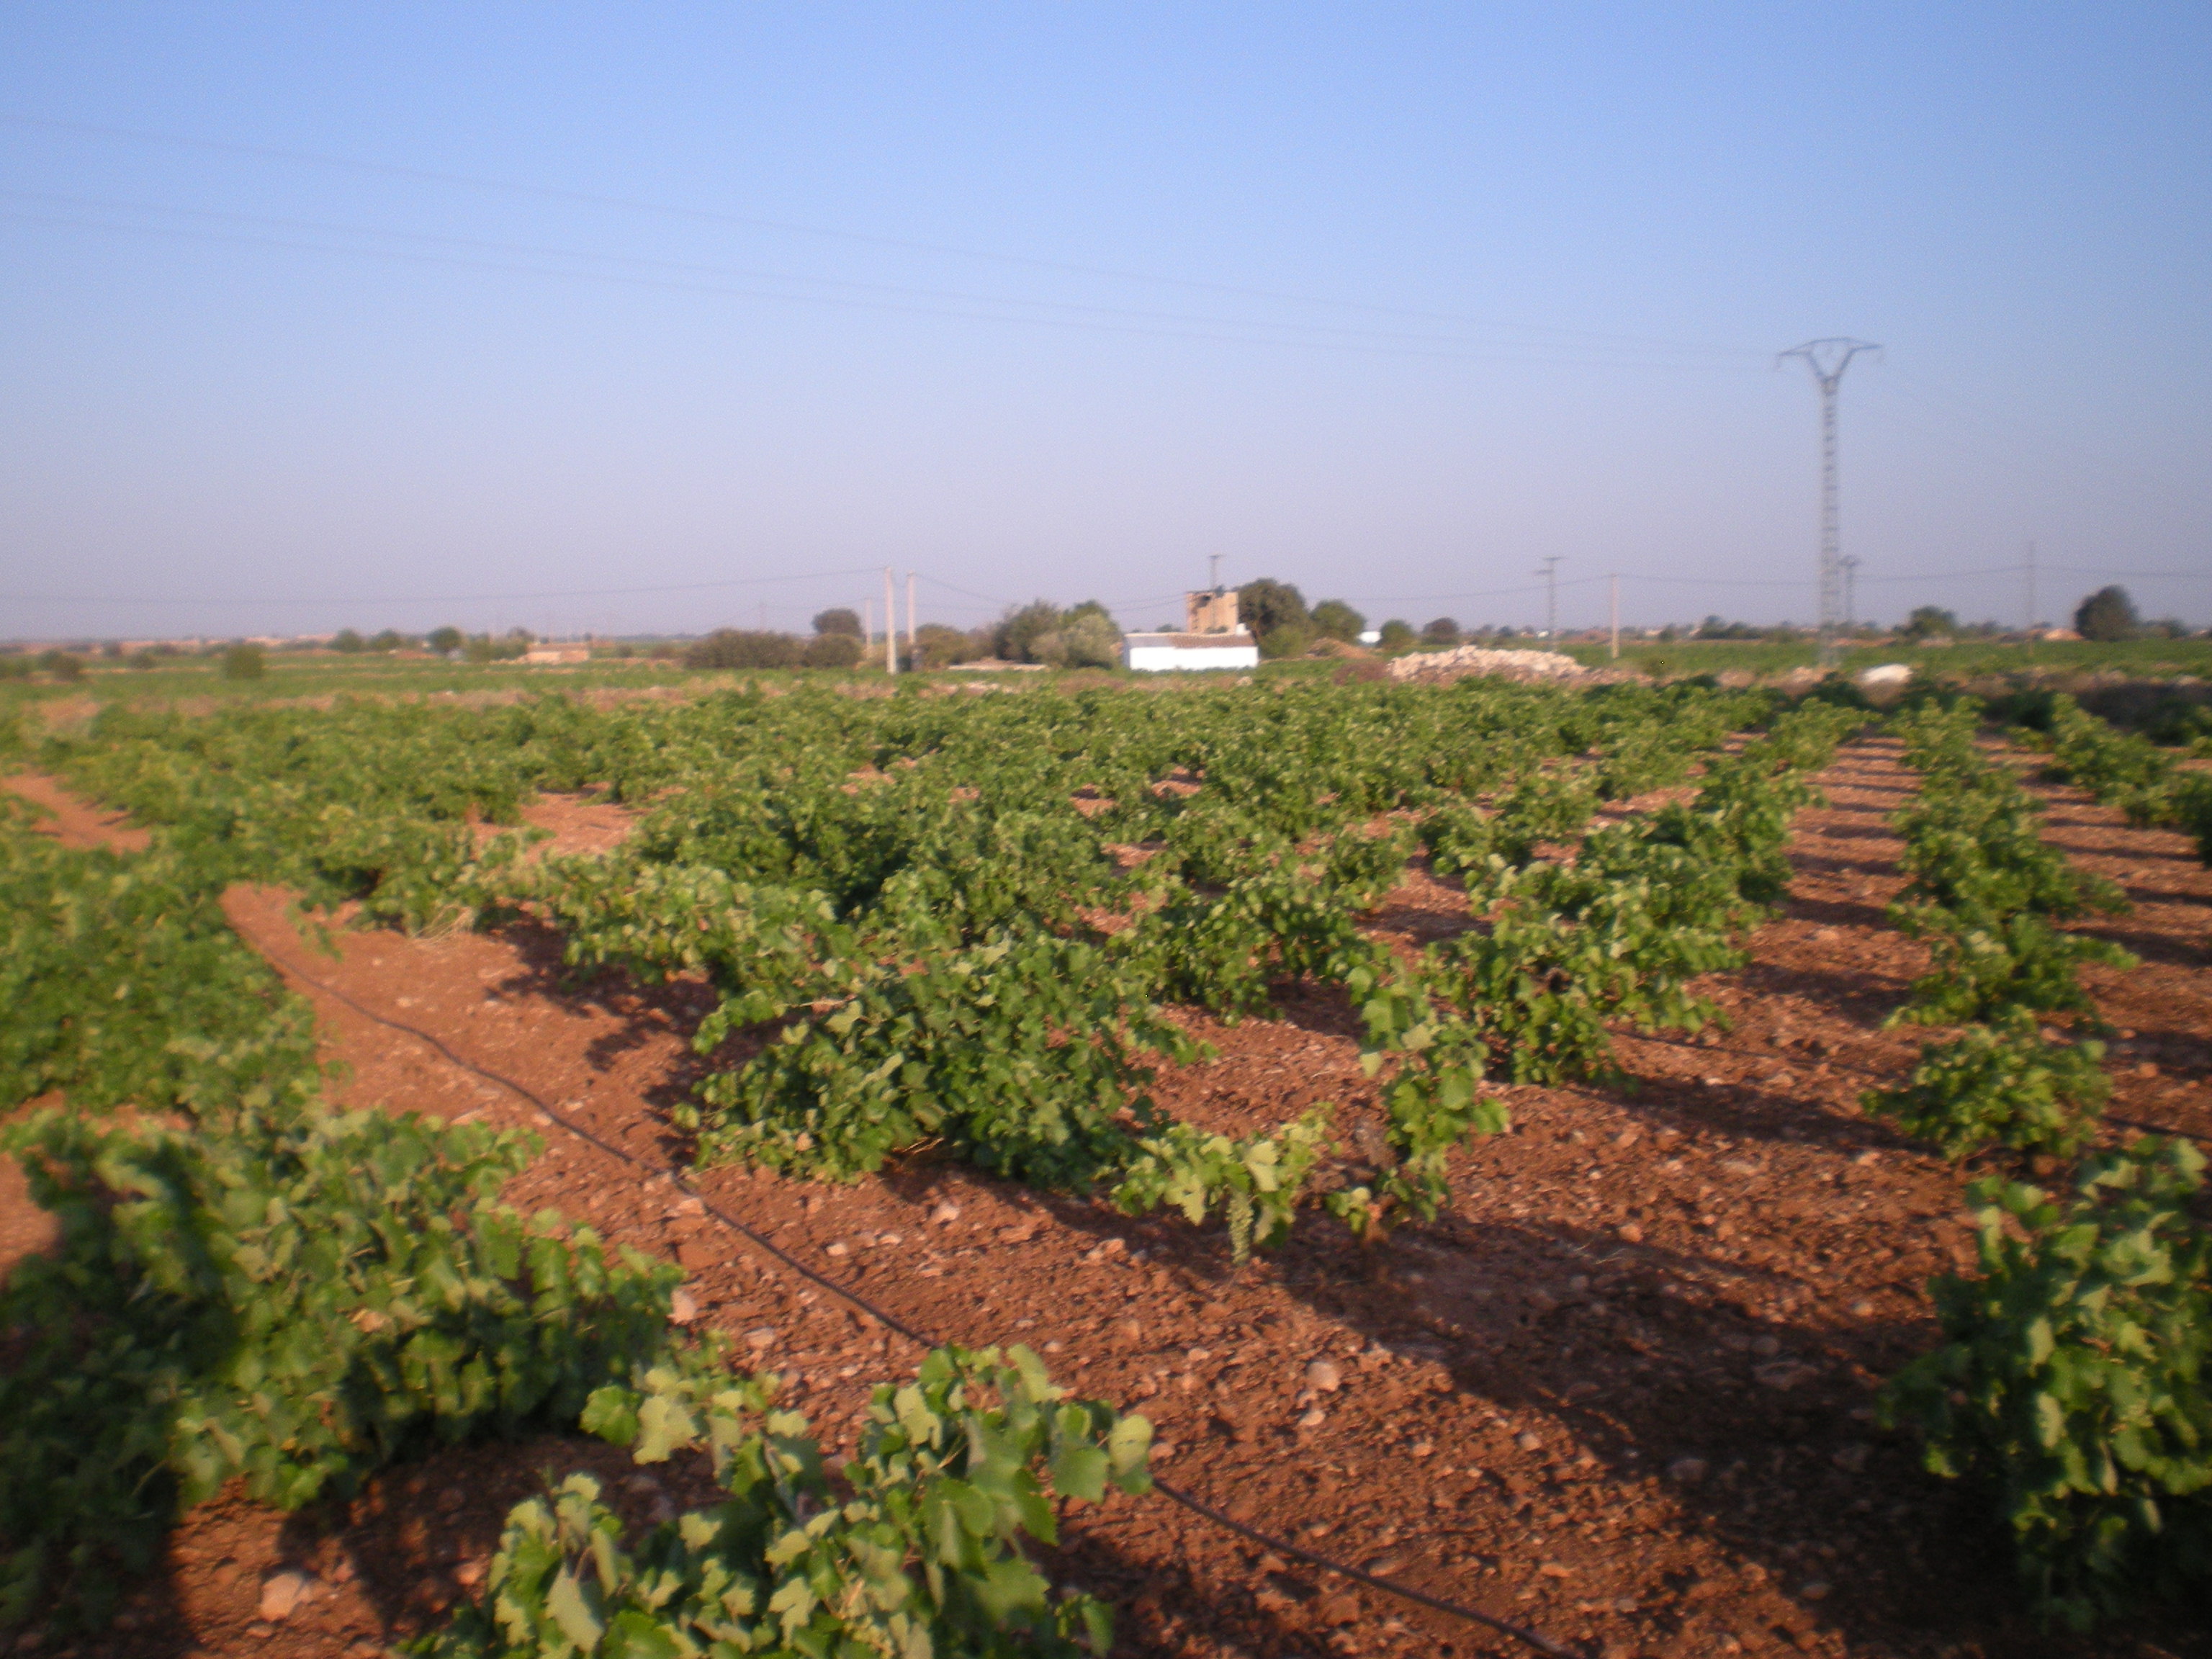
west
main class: Cropland
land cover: Vineyards
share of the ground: 25 - 50 %
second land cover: Other bare soil
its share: > 75 %
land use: Agriculture (excluding fallow land and kitchen gardens)
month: July
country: ES
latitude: 39.4831
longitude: -3.0503
